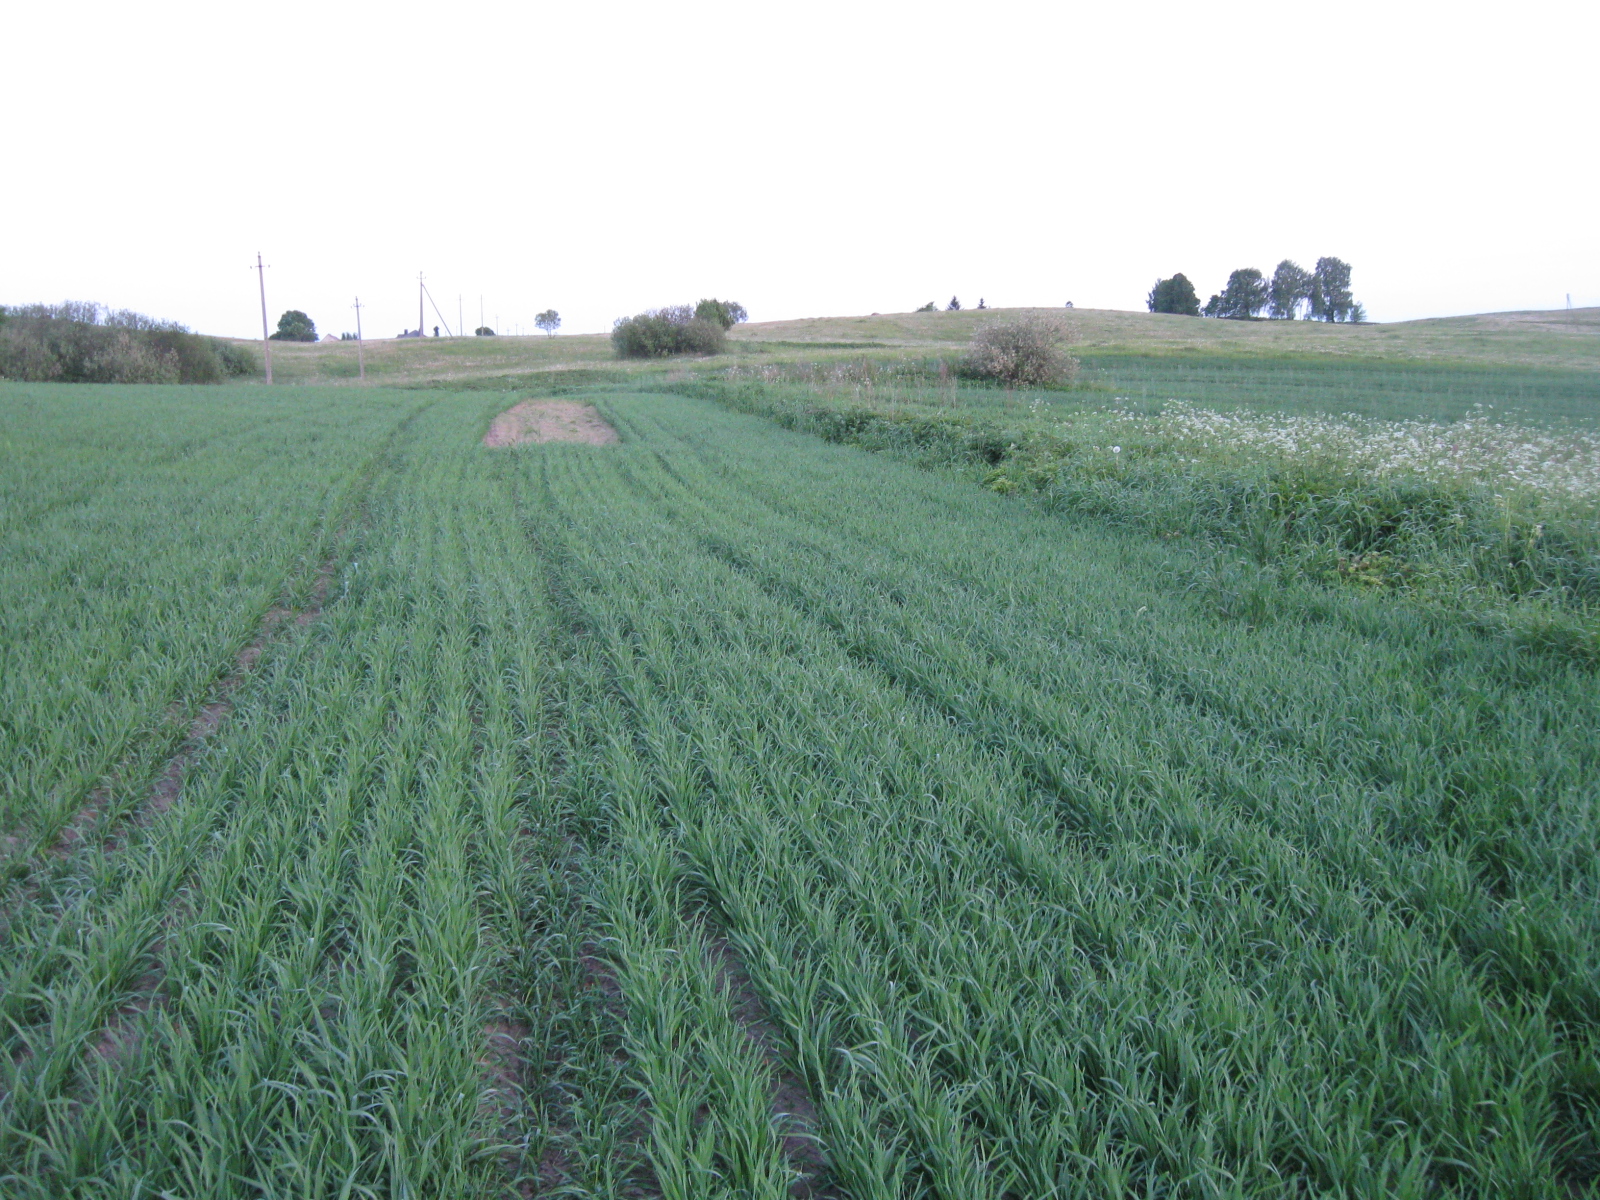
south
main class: Cropland
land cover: Common wheat
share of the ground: > 75 %
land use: Agriculture (excluding fallow land and kitchen gardens)
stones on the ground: < 10 %
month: May
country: LT
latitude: 54.5306
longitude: 22.7235
